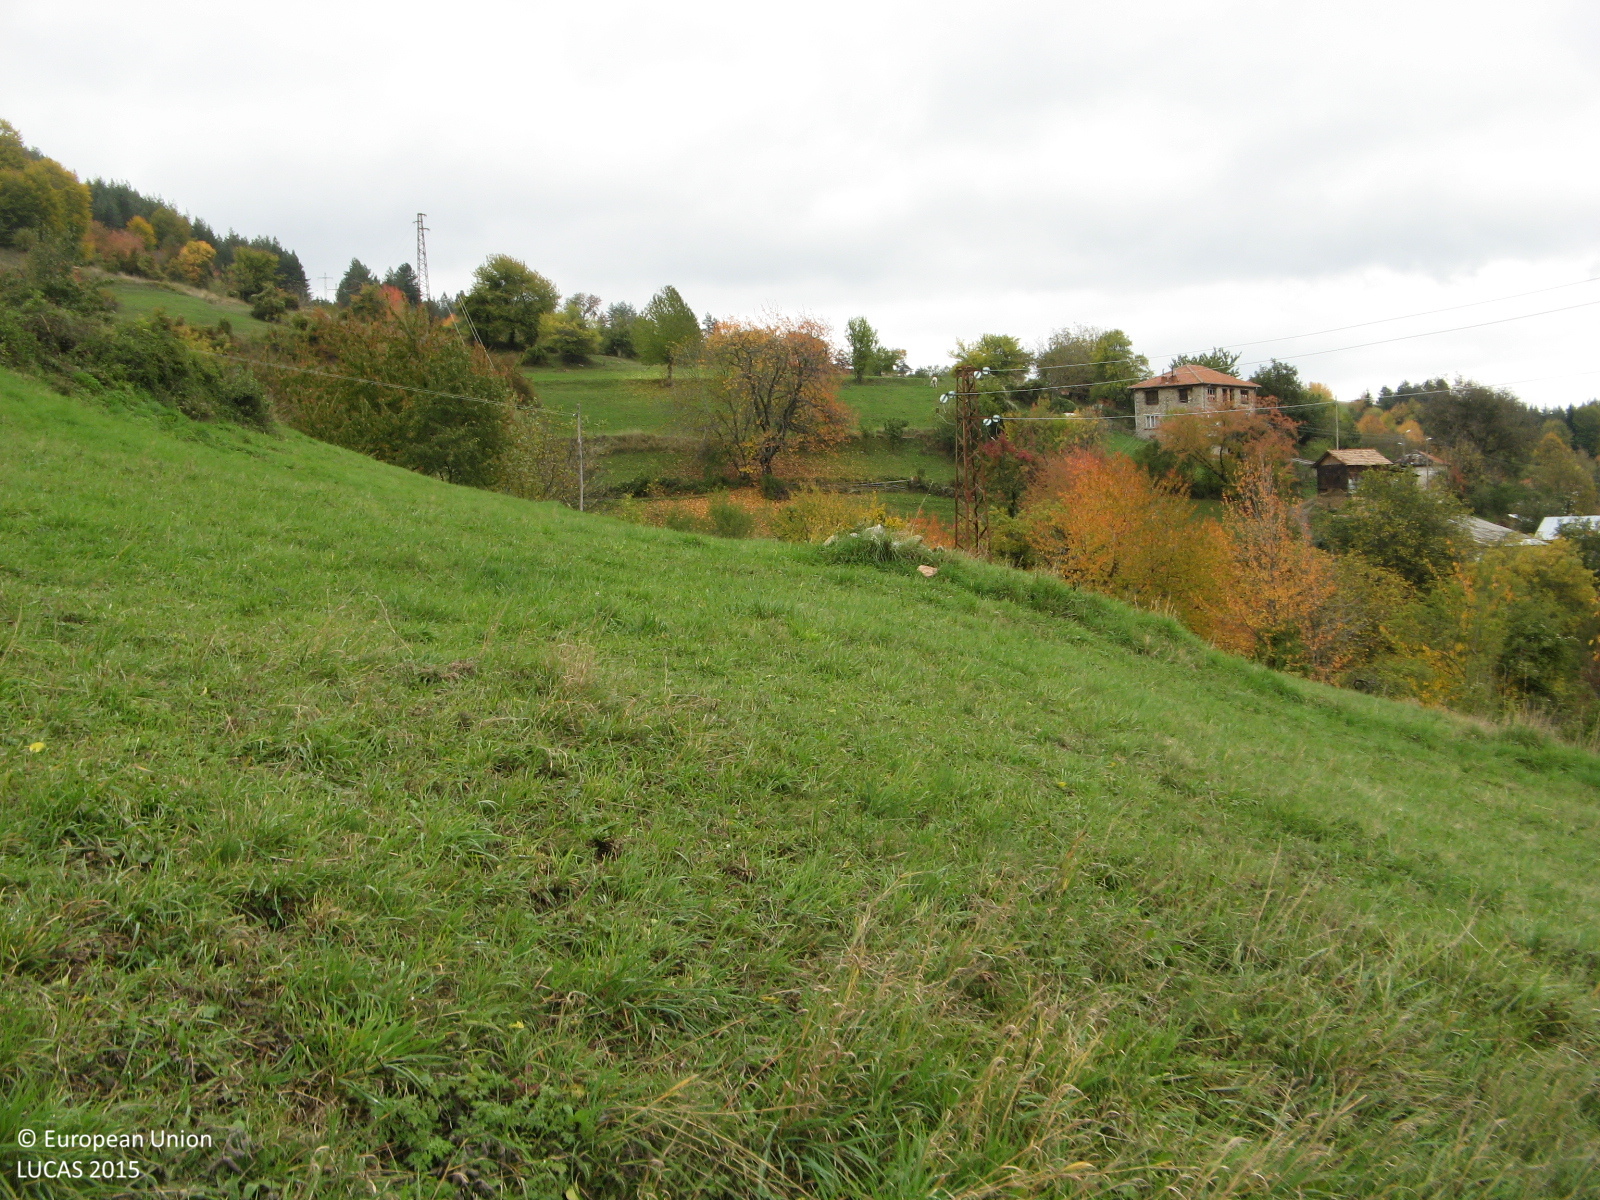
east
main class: Grassland
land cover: Grassland without tree/shrub cover
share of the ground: > 75 %
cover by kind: herbaceous plants 100 %
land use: Agriculture (excluding fallow land and kitchen gardens)
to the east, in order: Tracks; Grassland without tree/shrub cover; Grassland with sparse tree/shrub cover; Broadleaved woodland; Grassland with sparse tree/shrub cover; Rivers and streams; Grassland with sparse tree/shrub cover; Fences; Abandoned hedges; Grassland with sparse tree/shrub cover; Abandoned hedges; Tracks; Grass margins; Fences; Spontaneously vegetated surfaces
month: October
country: BG
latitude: 41.5979
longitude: 24.7906
